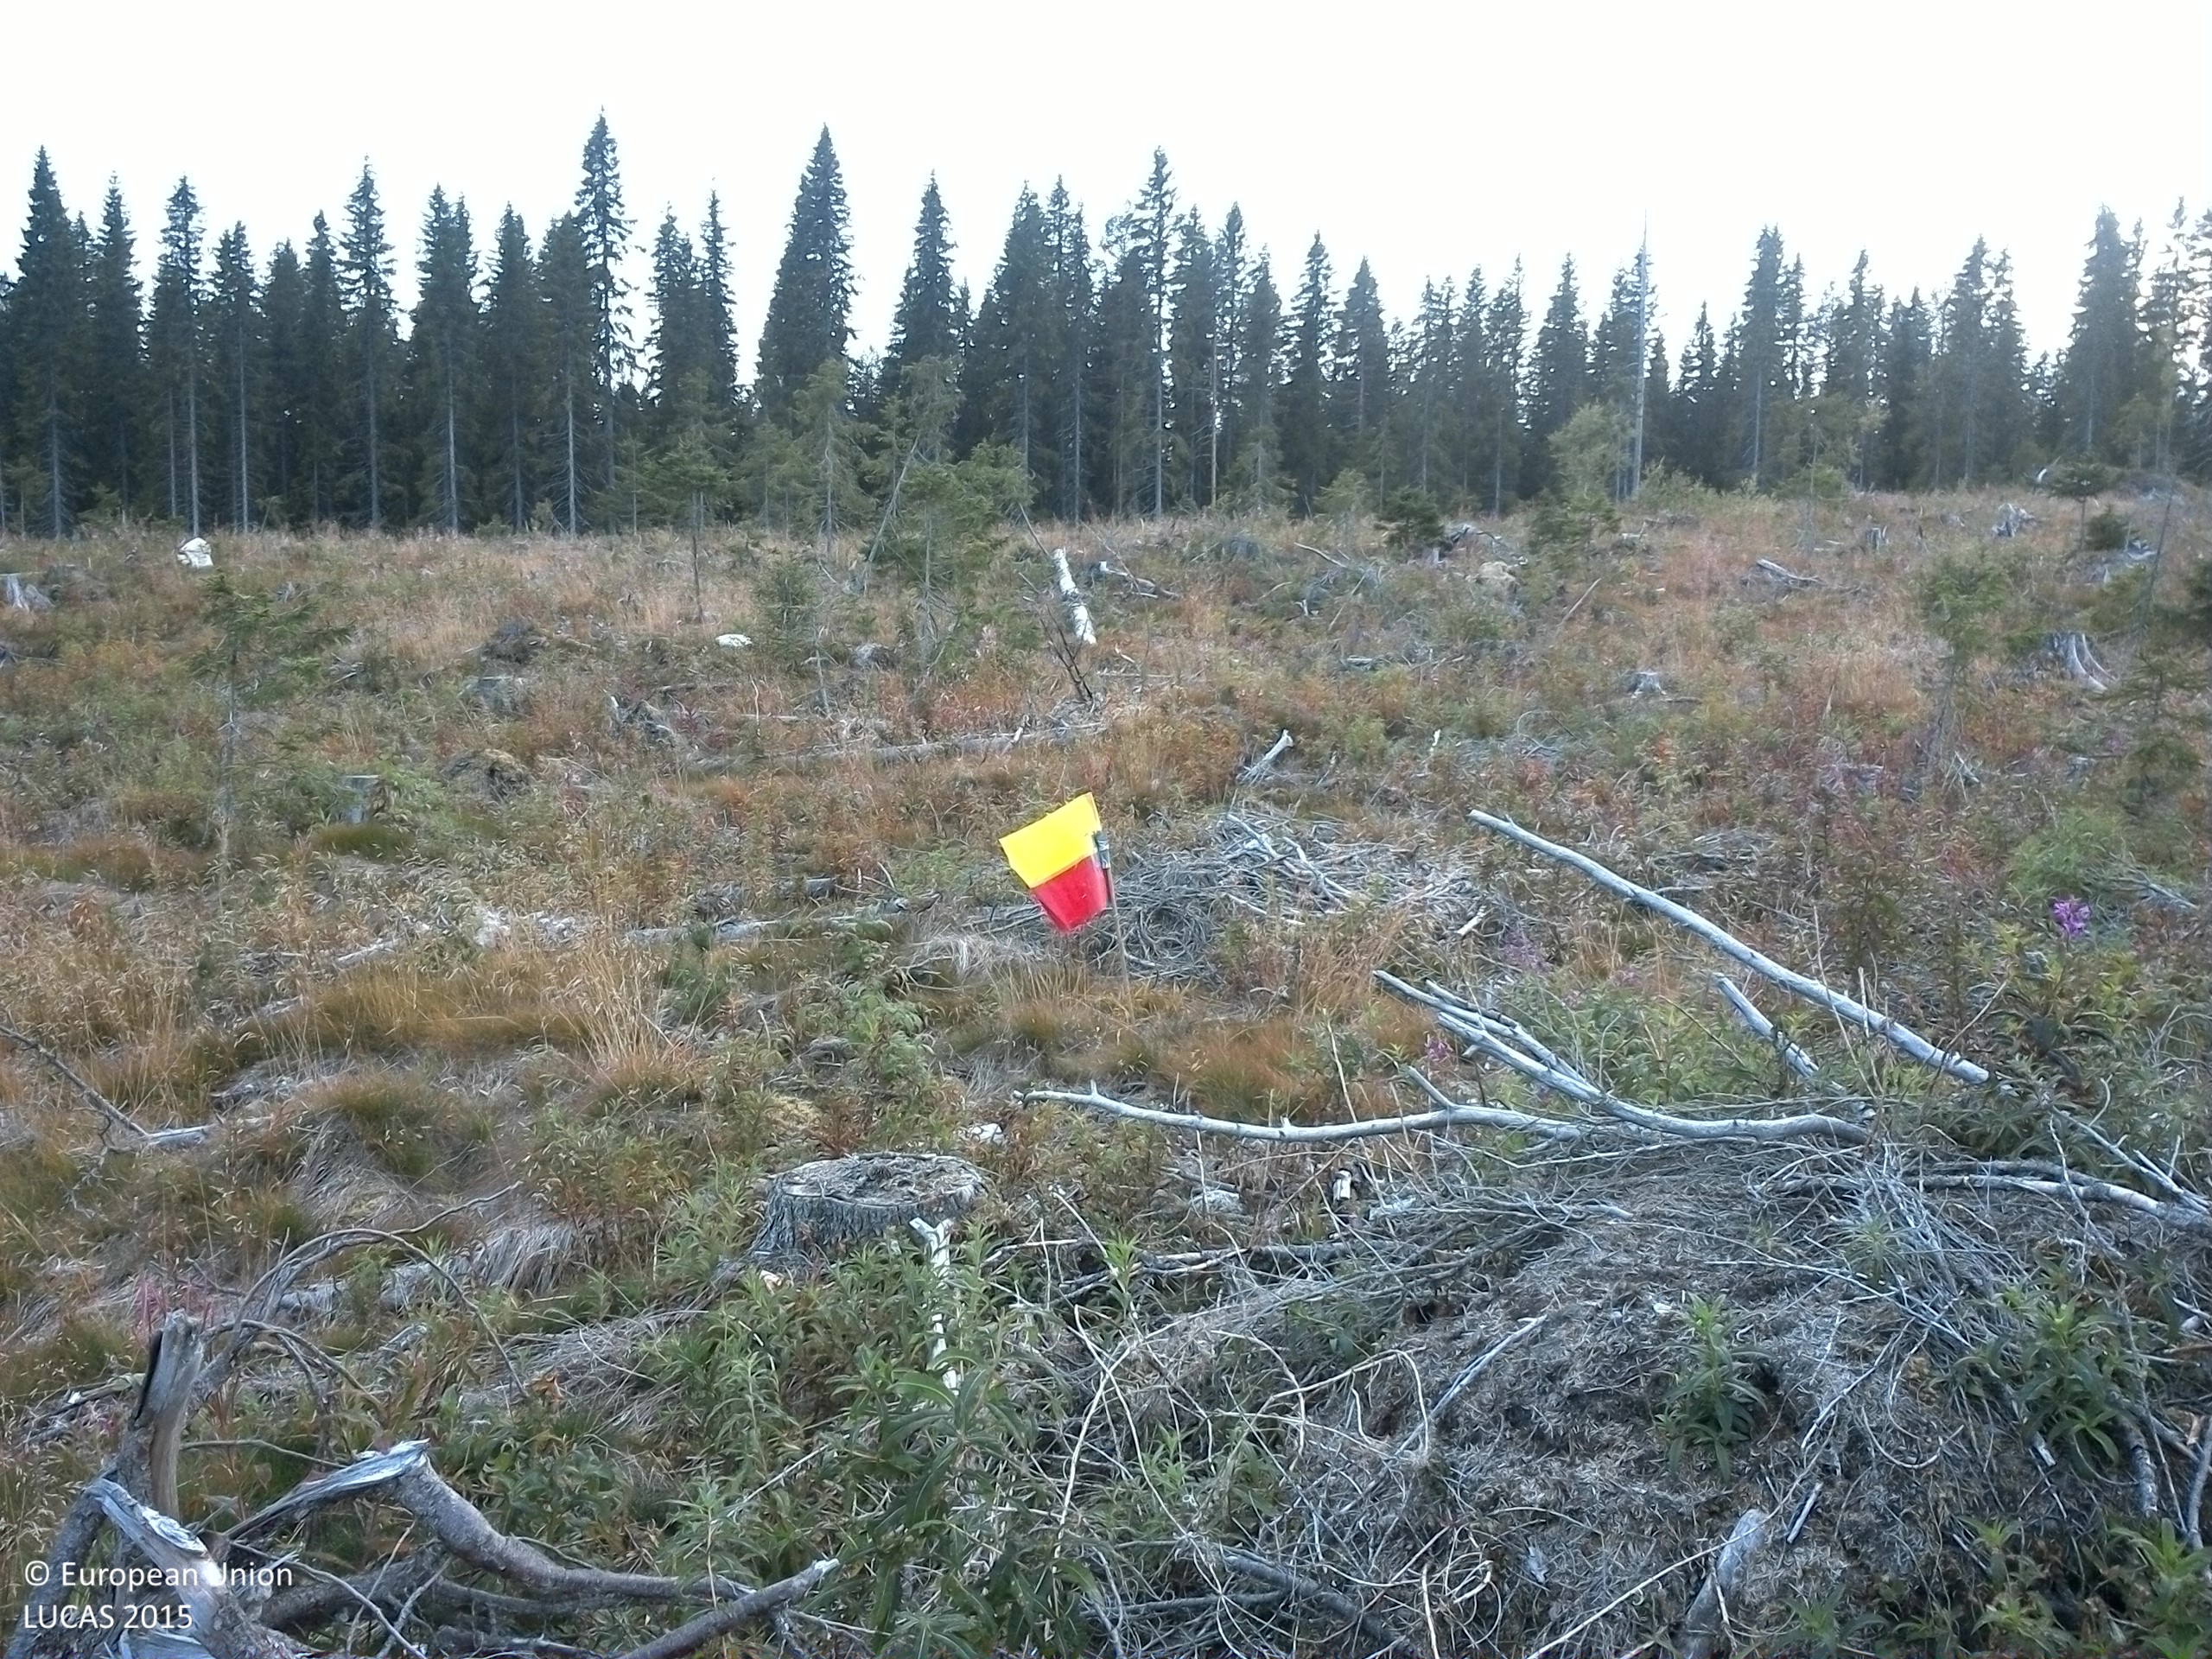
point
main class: Grassland
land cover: Grassland with sparse tree/shrub cover
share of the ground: > 75 %
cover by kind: herbaceous plants 85 %, coniferous forest trees 5 %, lichens and mosses 5 %, unconsolidated bare surface 5 %
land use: Forestry
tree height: < 5 m
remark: Clear cut
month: September
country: SE
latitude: 64.0799
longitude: 16.5932
